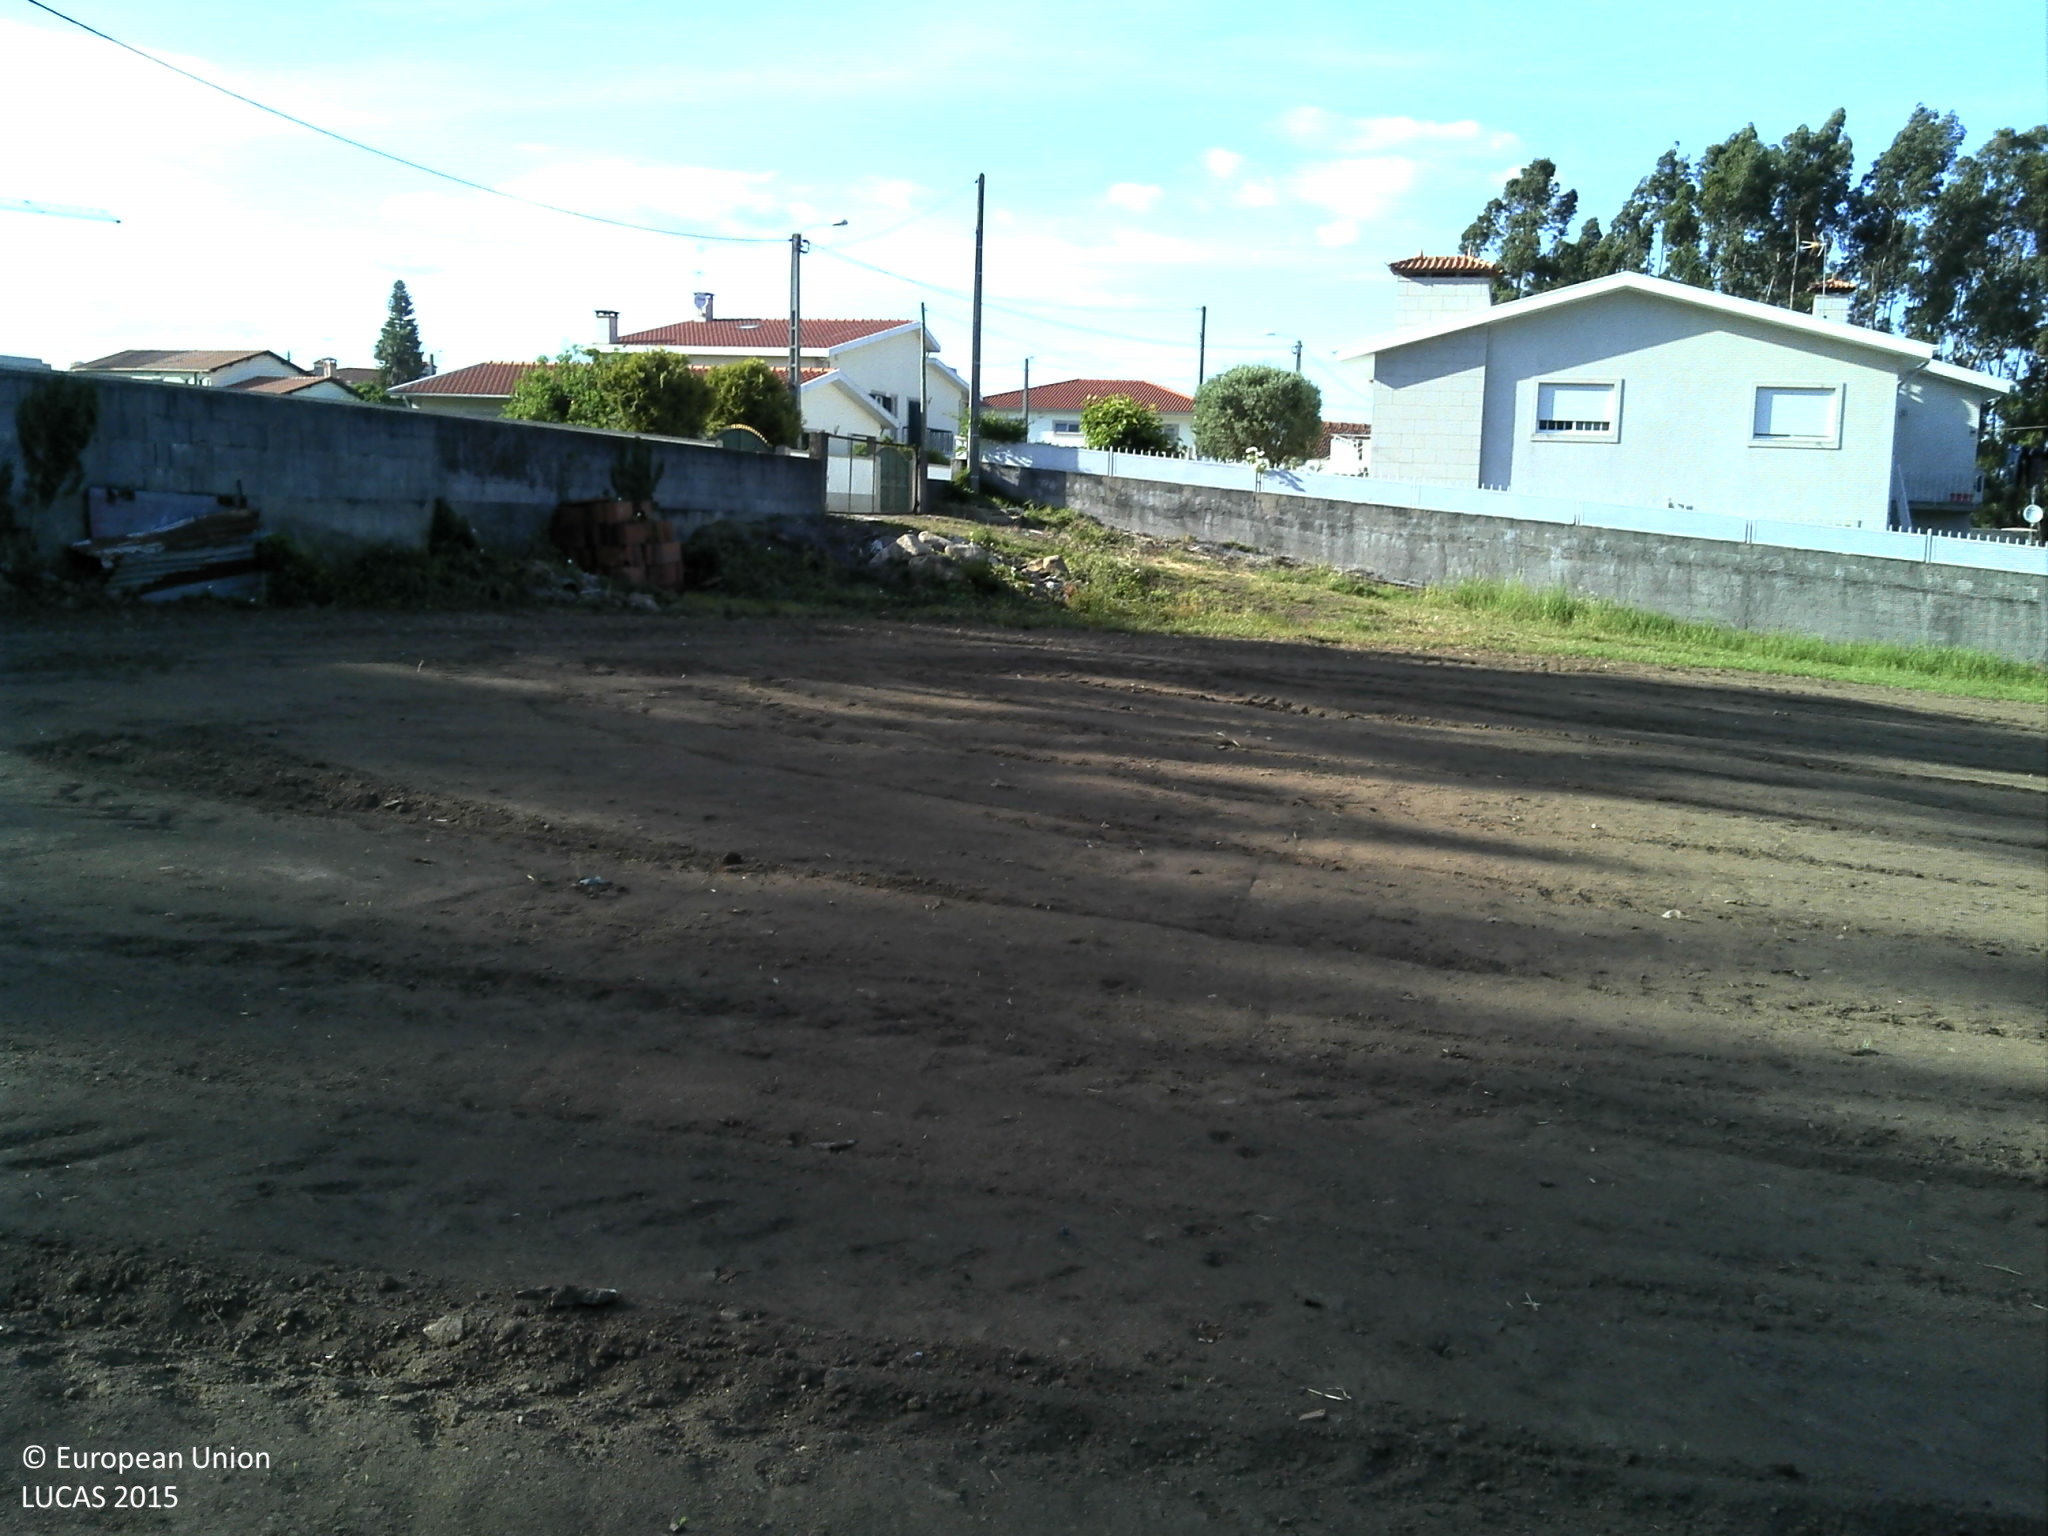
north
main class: Cropland
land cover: Maize
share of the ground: < 10 %
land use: Agriculture (excluding fallow land and kitchen gardens)
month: May
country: PT
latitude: 41.4136
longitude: -8.5924
